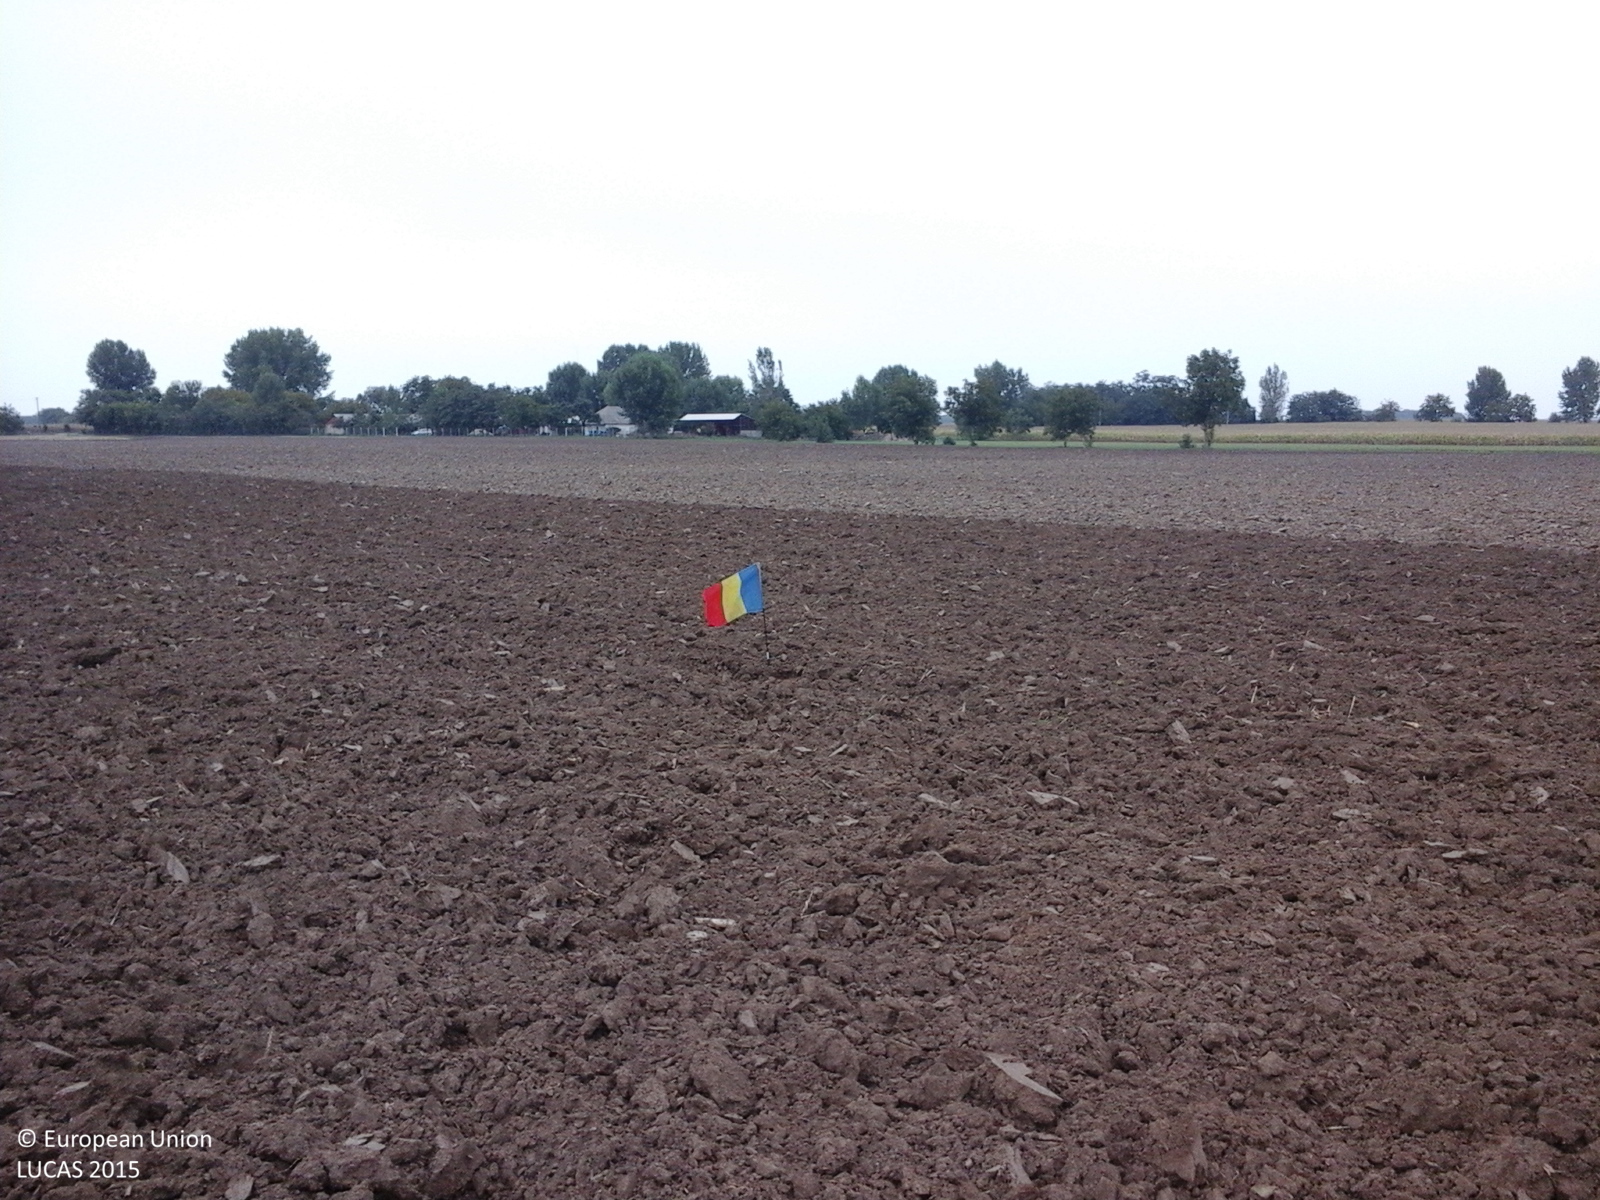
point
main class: Cropland
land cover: Common wheat
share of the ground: < 10 %
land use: Agriculture (excluding fallow land and kitchen gardens)
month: September
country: RO
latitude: 47.4680
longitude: 22.0570
